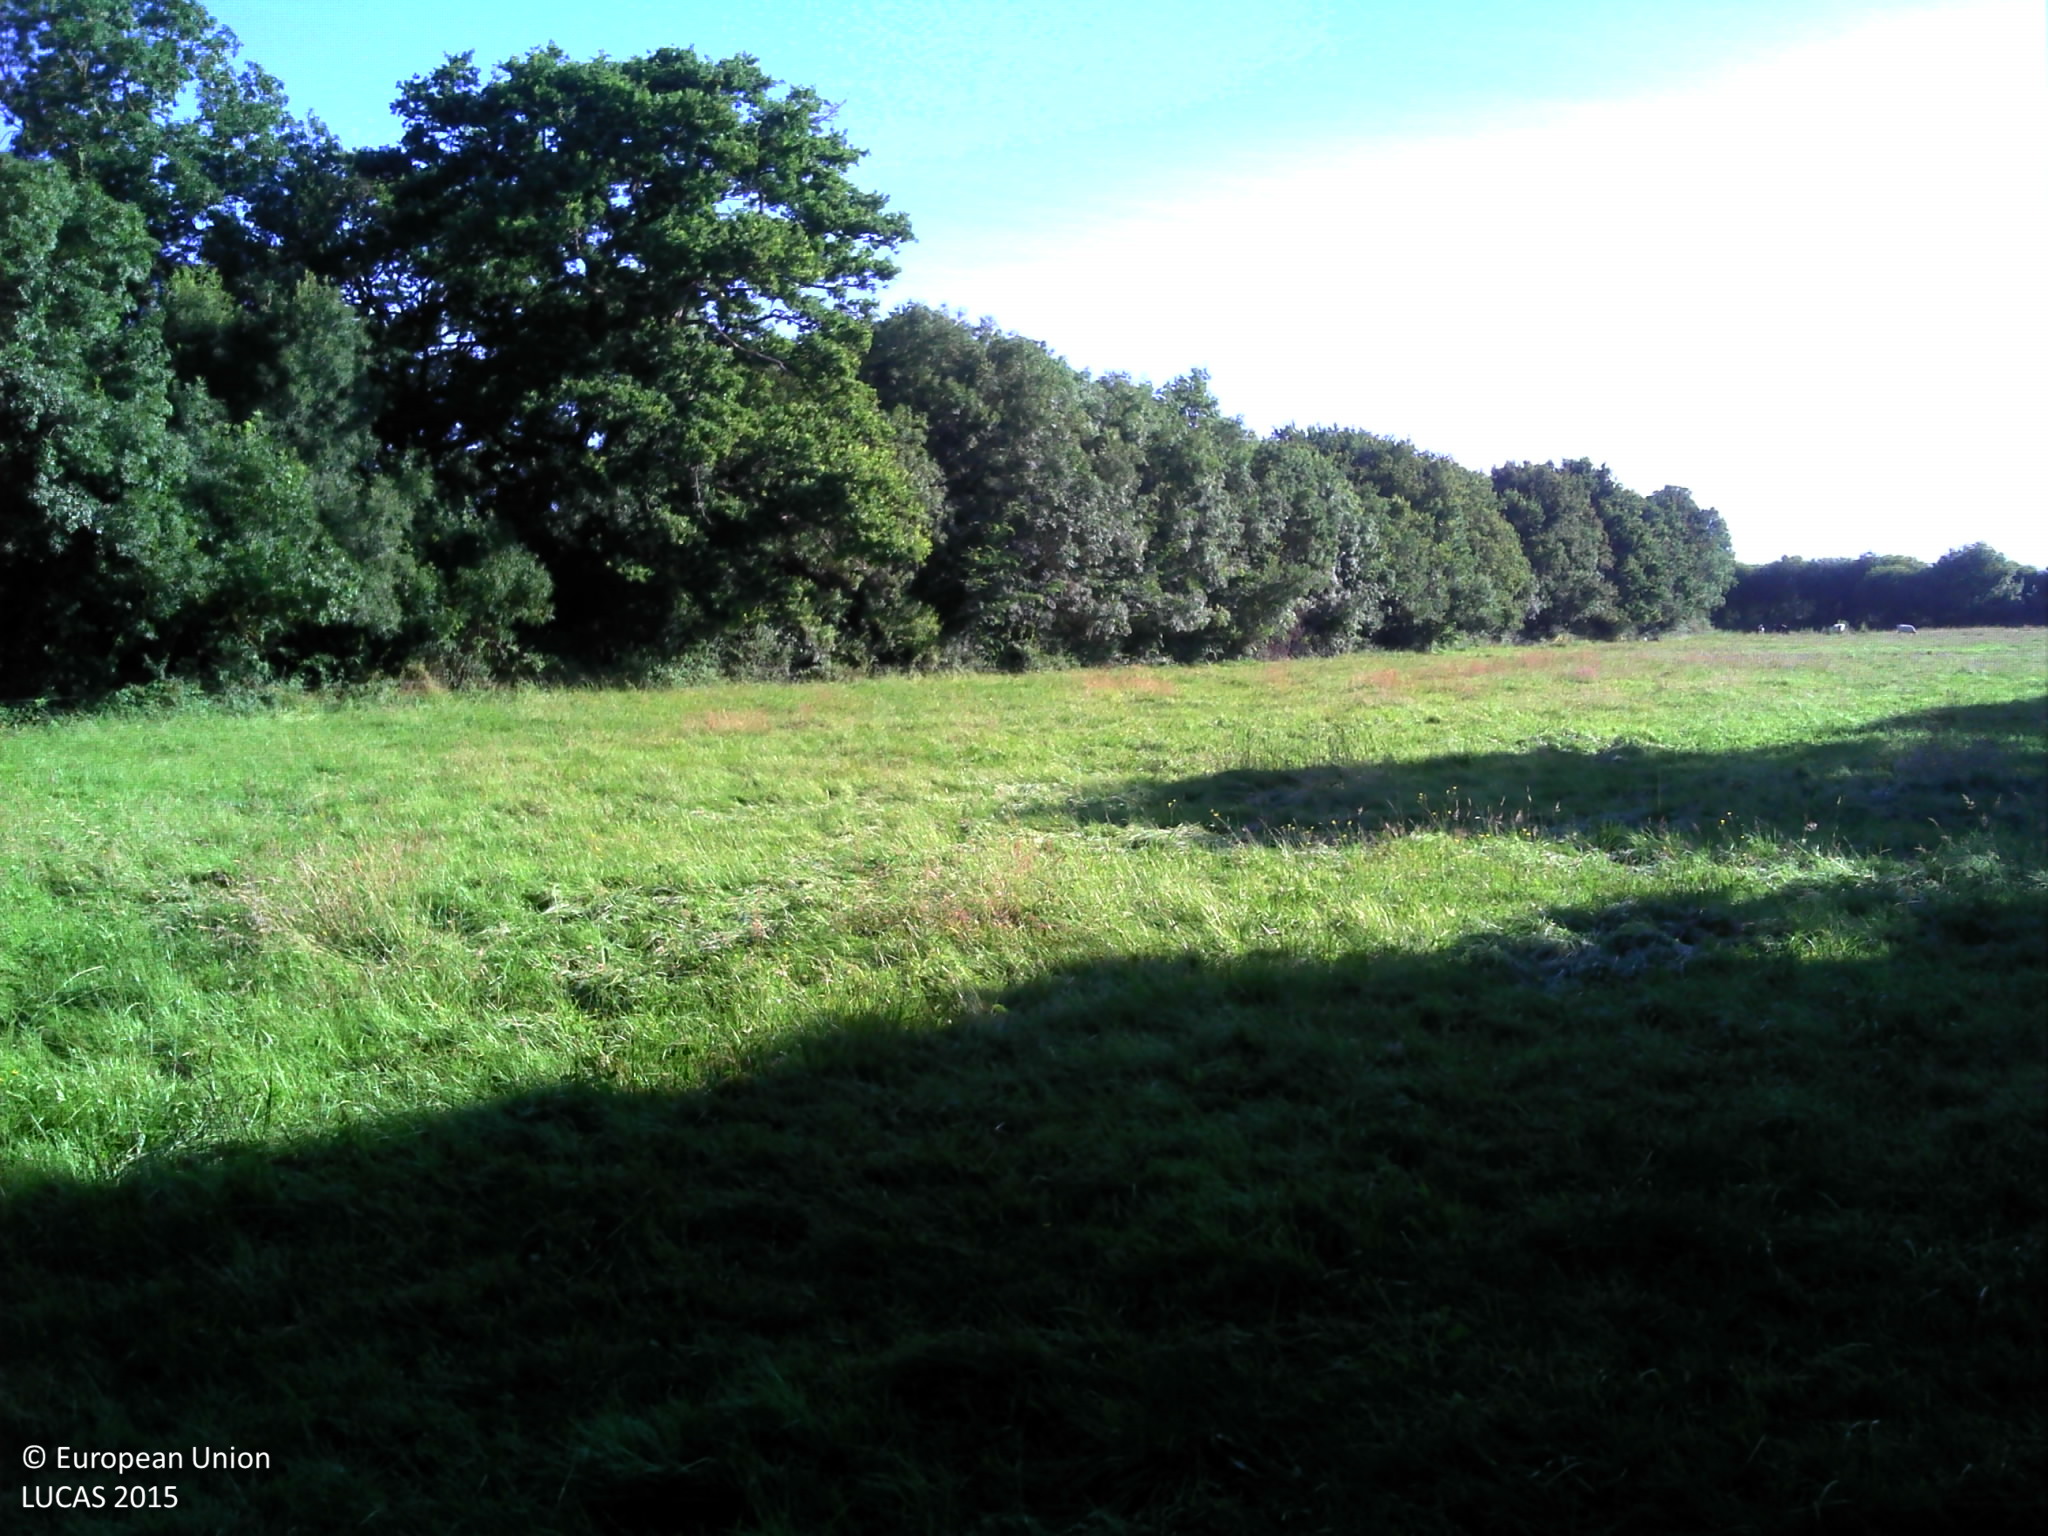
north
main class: Grassland
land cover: Grassland without tree/shrub cover
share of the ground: > 75 %
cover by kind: herbaceous plants 100 %
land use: Agriculture (excluding fallow land and kitchen gardens)
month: June
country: FR
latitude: 46.9710
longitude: -1.7815
